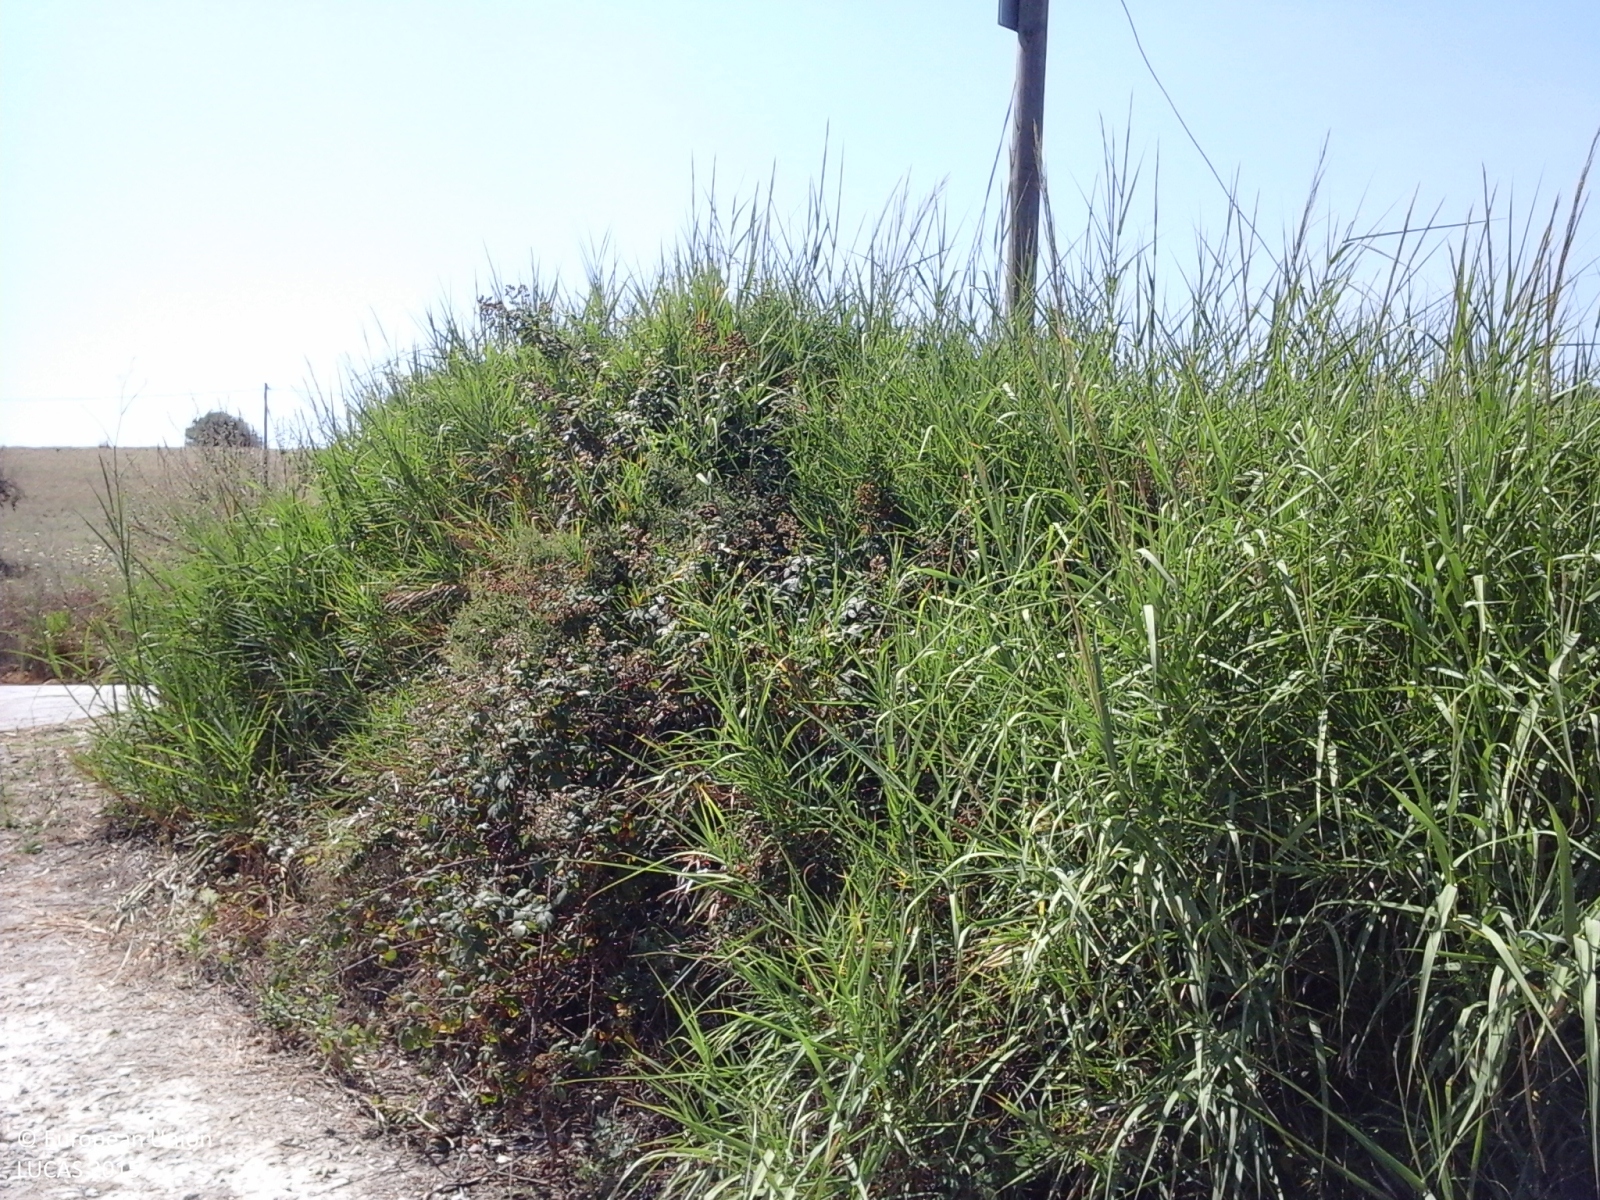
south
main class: Cropland
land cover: Mixed cereals for fodder
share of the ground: > 75 %
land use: Agriculture (excluding fallow land and kitchen gardens)
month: July
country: IT
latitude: 36.9860
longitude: 14.8716
